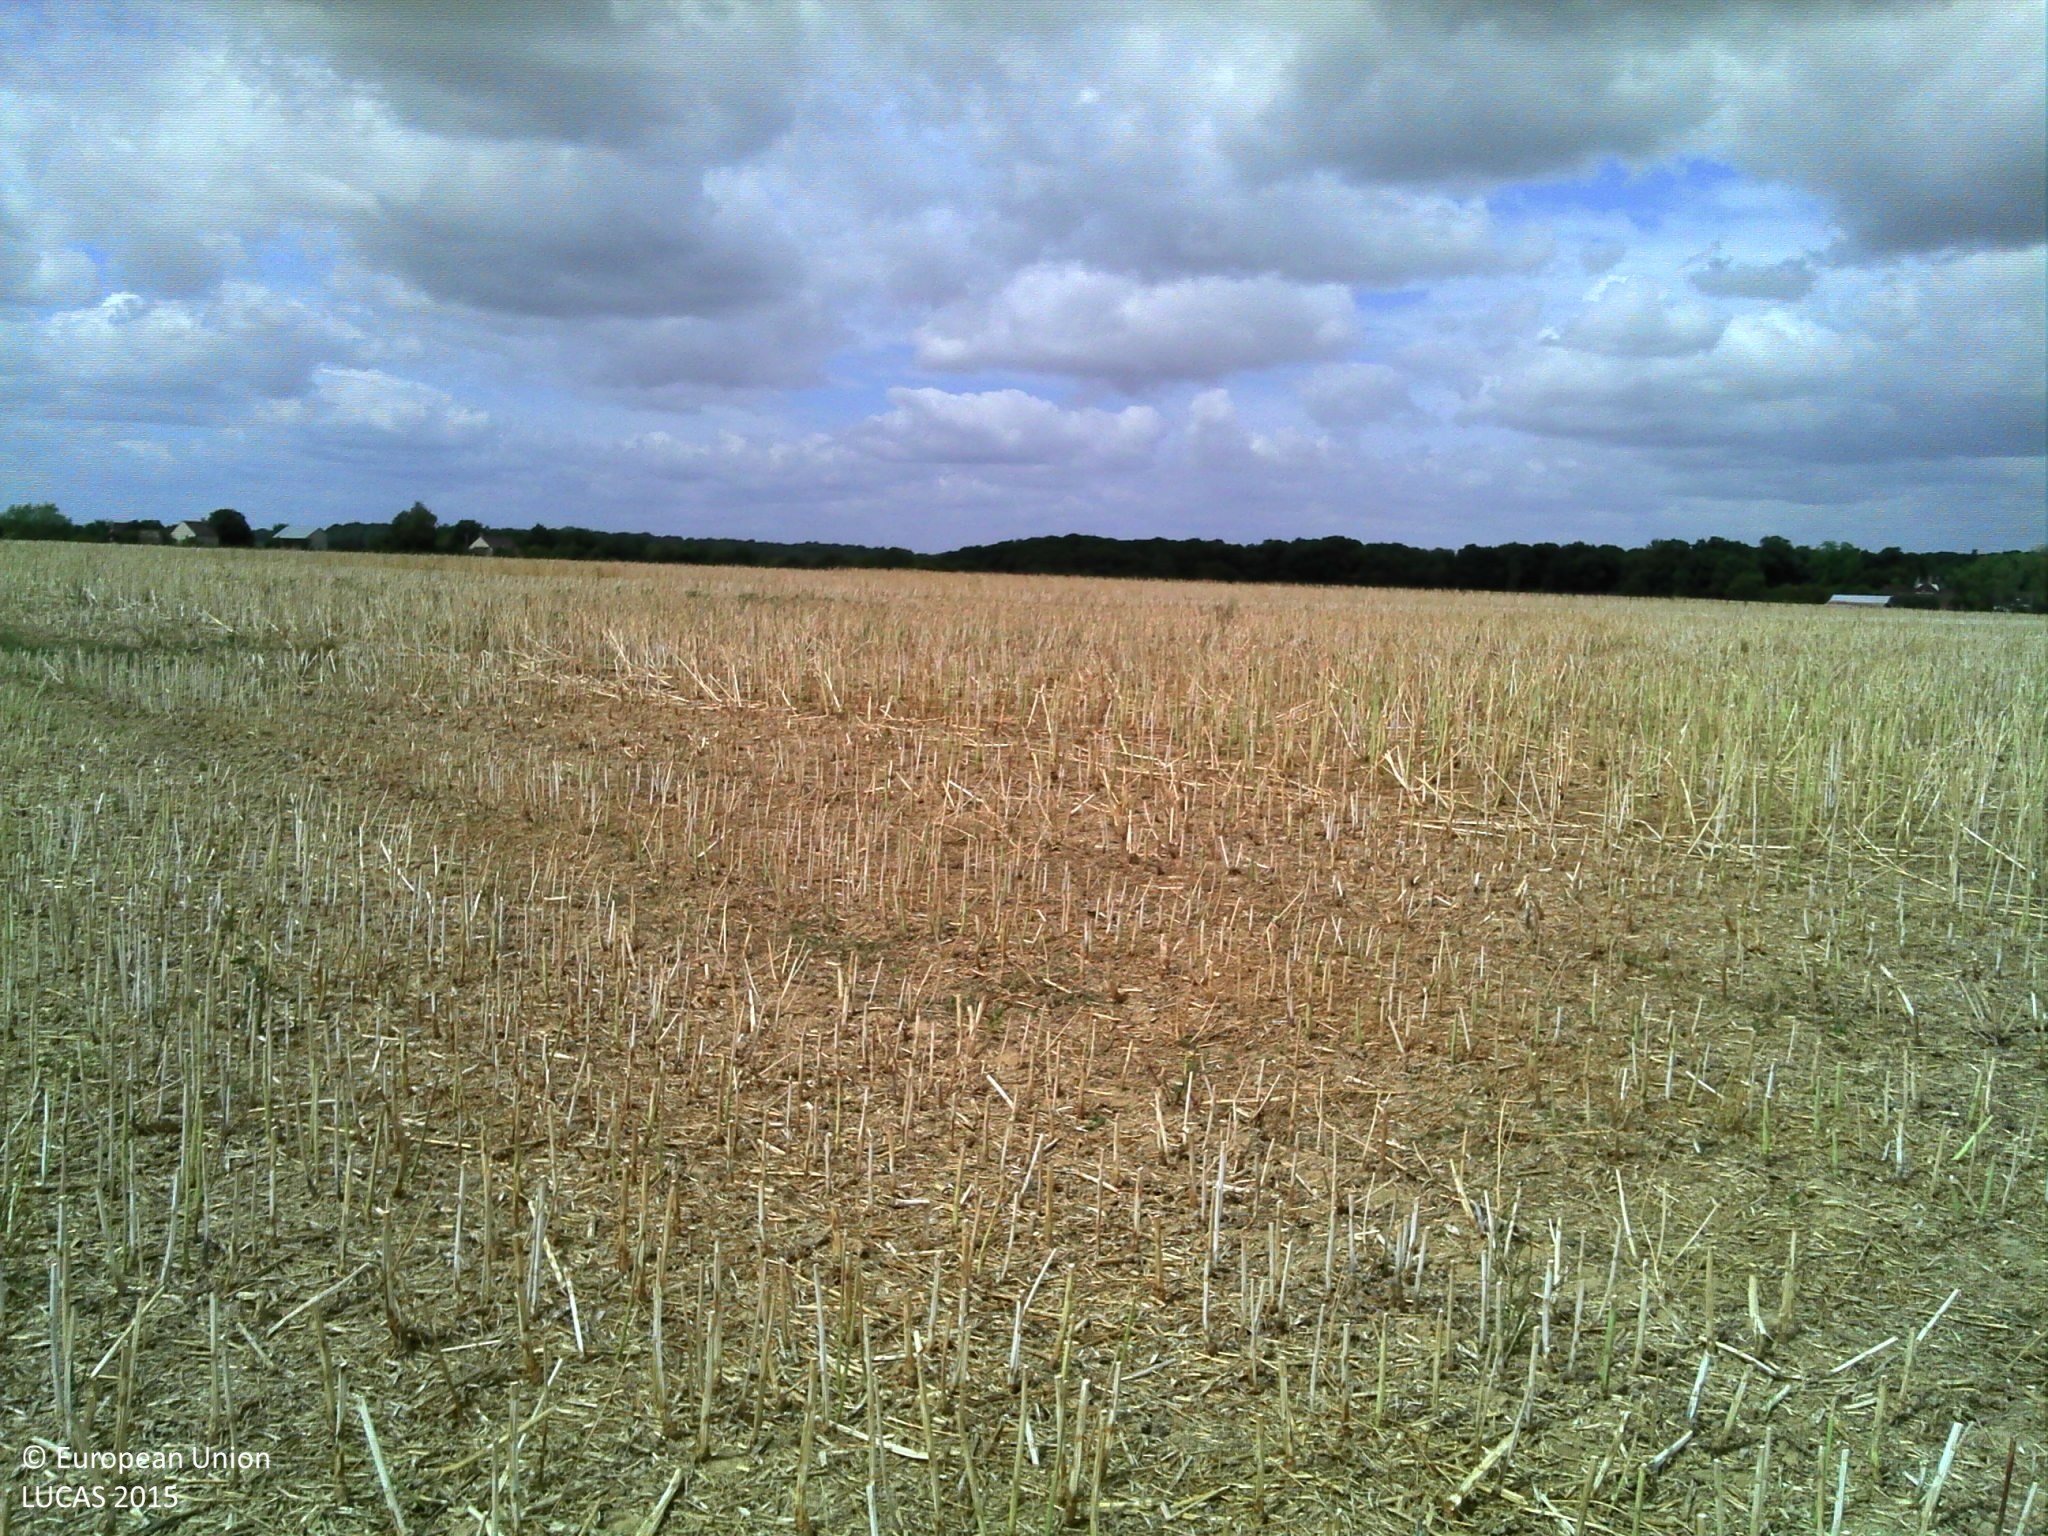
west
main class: Cropland
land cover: Rape and turnip rape
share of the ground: > 75 %
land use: Agriculture (excluding fallow land and kitchen gardens)
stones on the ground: < 10 %
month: July
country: FR
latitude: 47.8779
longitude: 3.0538
